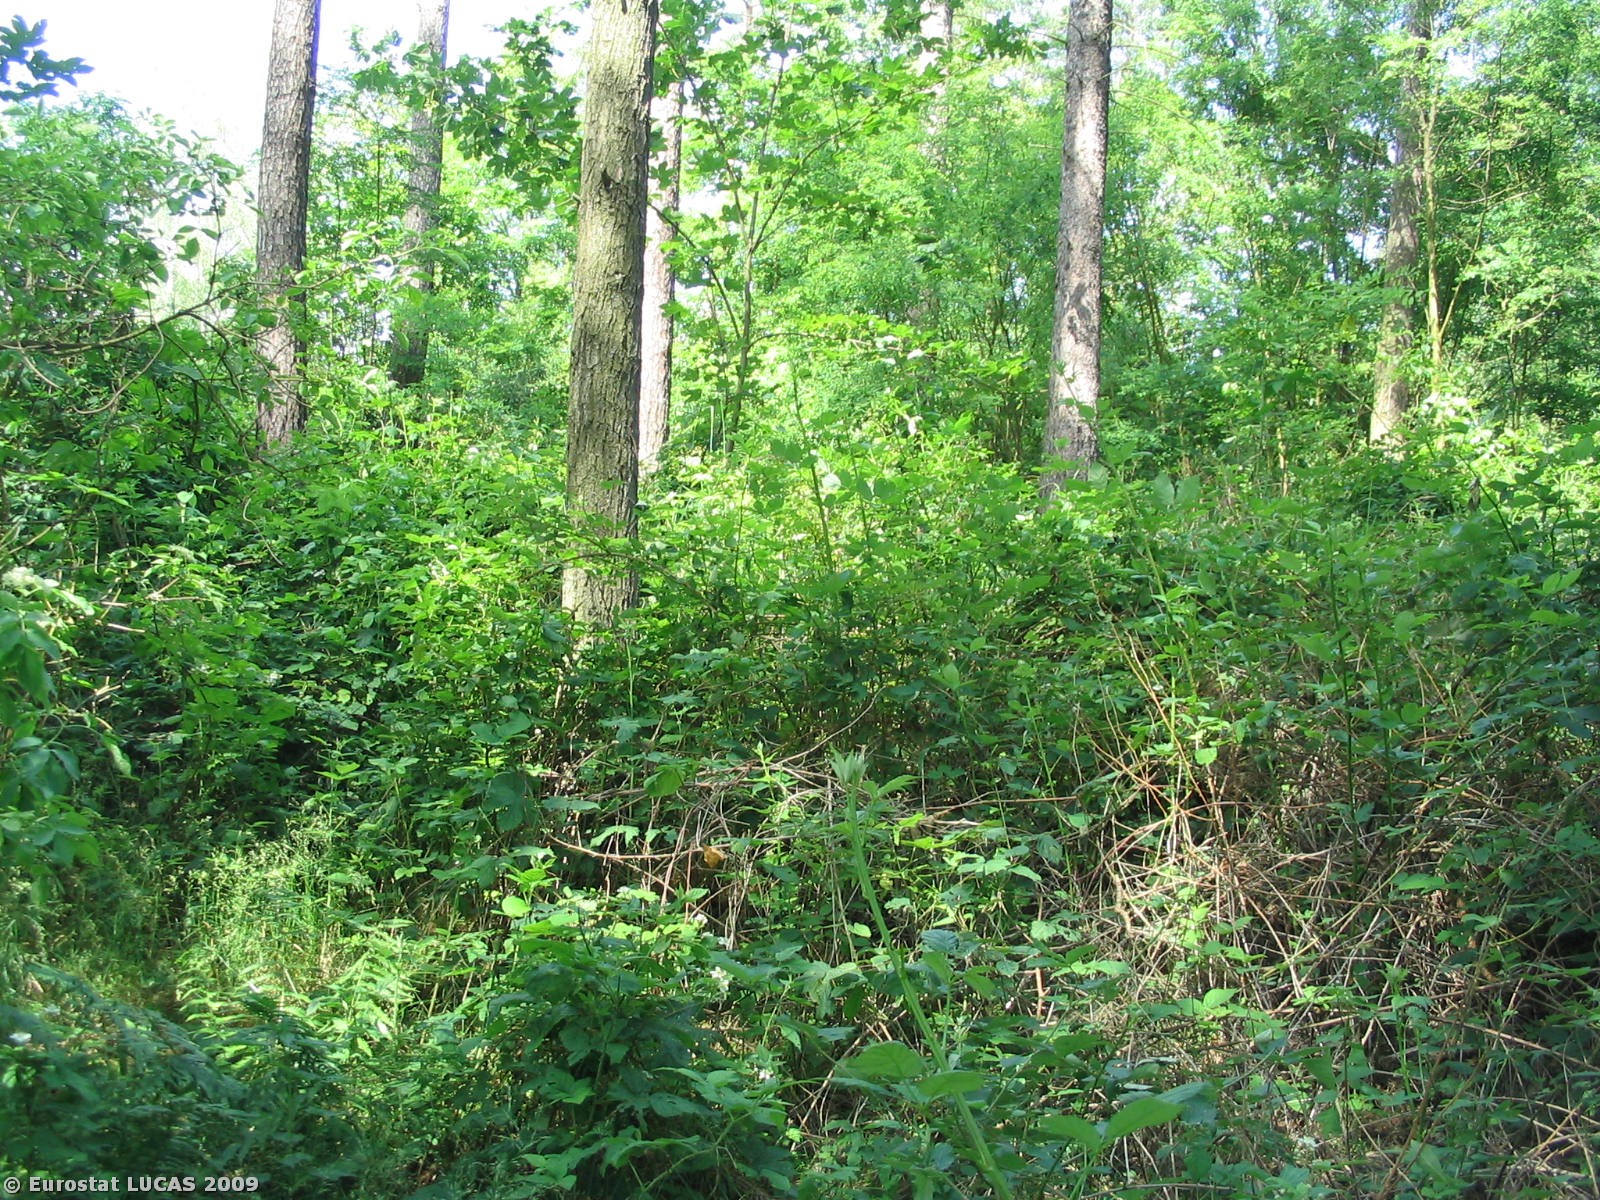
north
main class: Woodland
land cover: Mixed woodland
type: hemiboreal forest and nemoral coniferous forest and mixed broadleaved-coniferous forest
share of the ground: > 75 %
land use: Forestry
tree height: > 5 m
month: June
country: CZ
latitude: 49.3334
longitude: 16.4609
